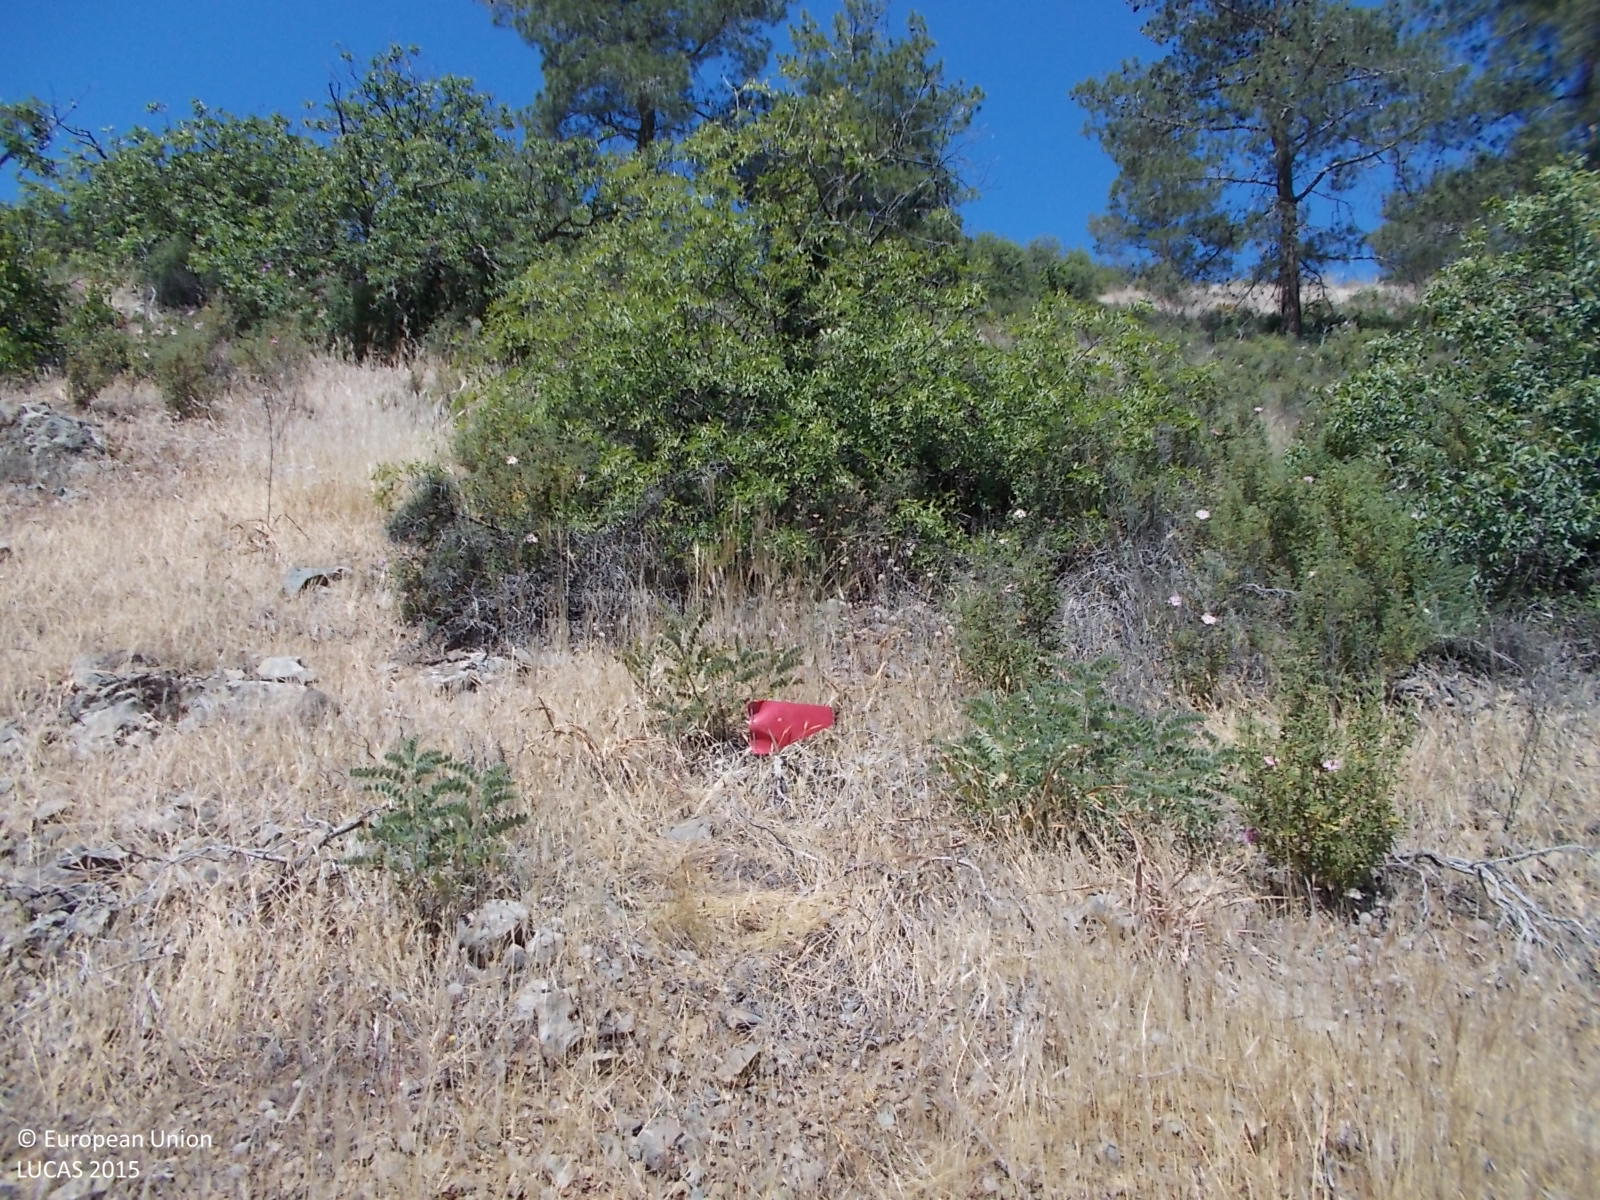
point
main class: Shrubland
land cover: Shrubland with sparse tree cover
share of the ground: > 75 %
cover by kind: shrubs 95 %, broadleaved forest trees 5 %
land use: Semi-natural and natural areas not in use
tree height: < 5 m
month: May
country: CY
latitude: 34.9687
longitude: 33.1233
